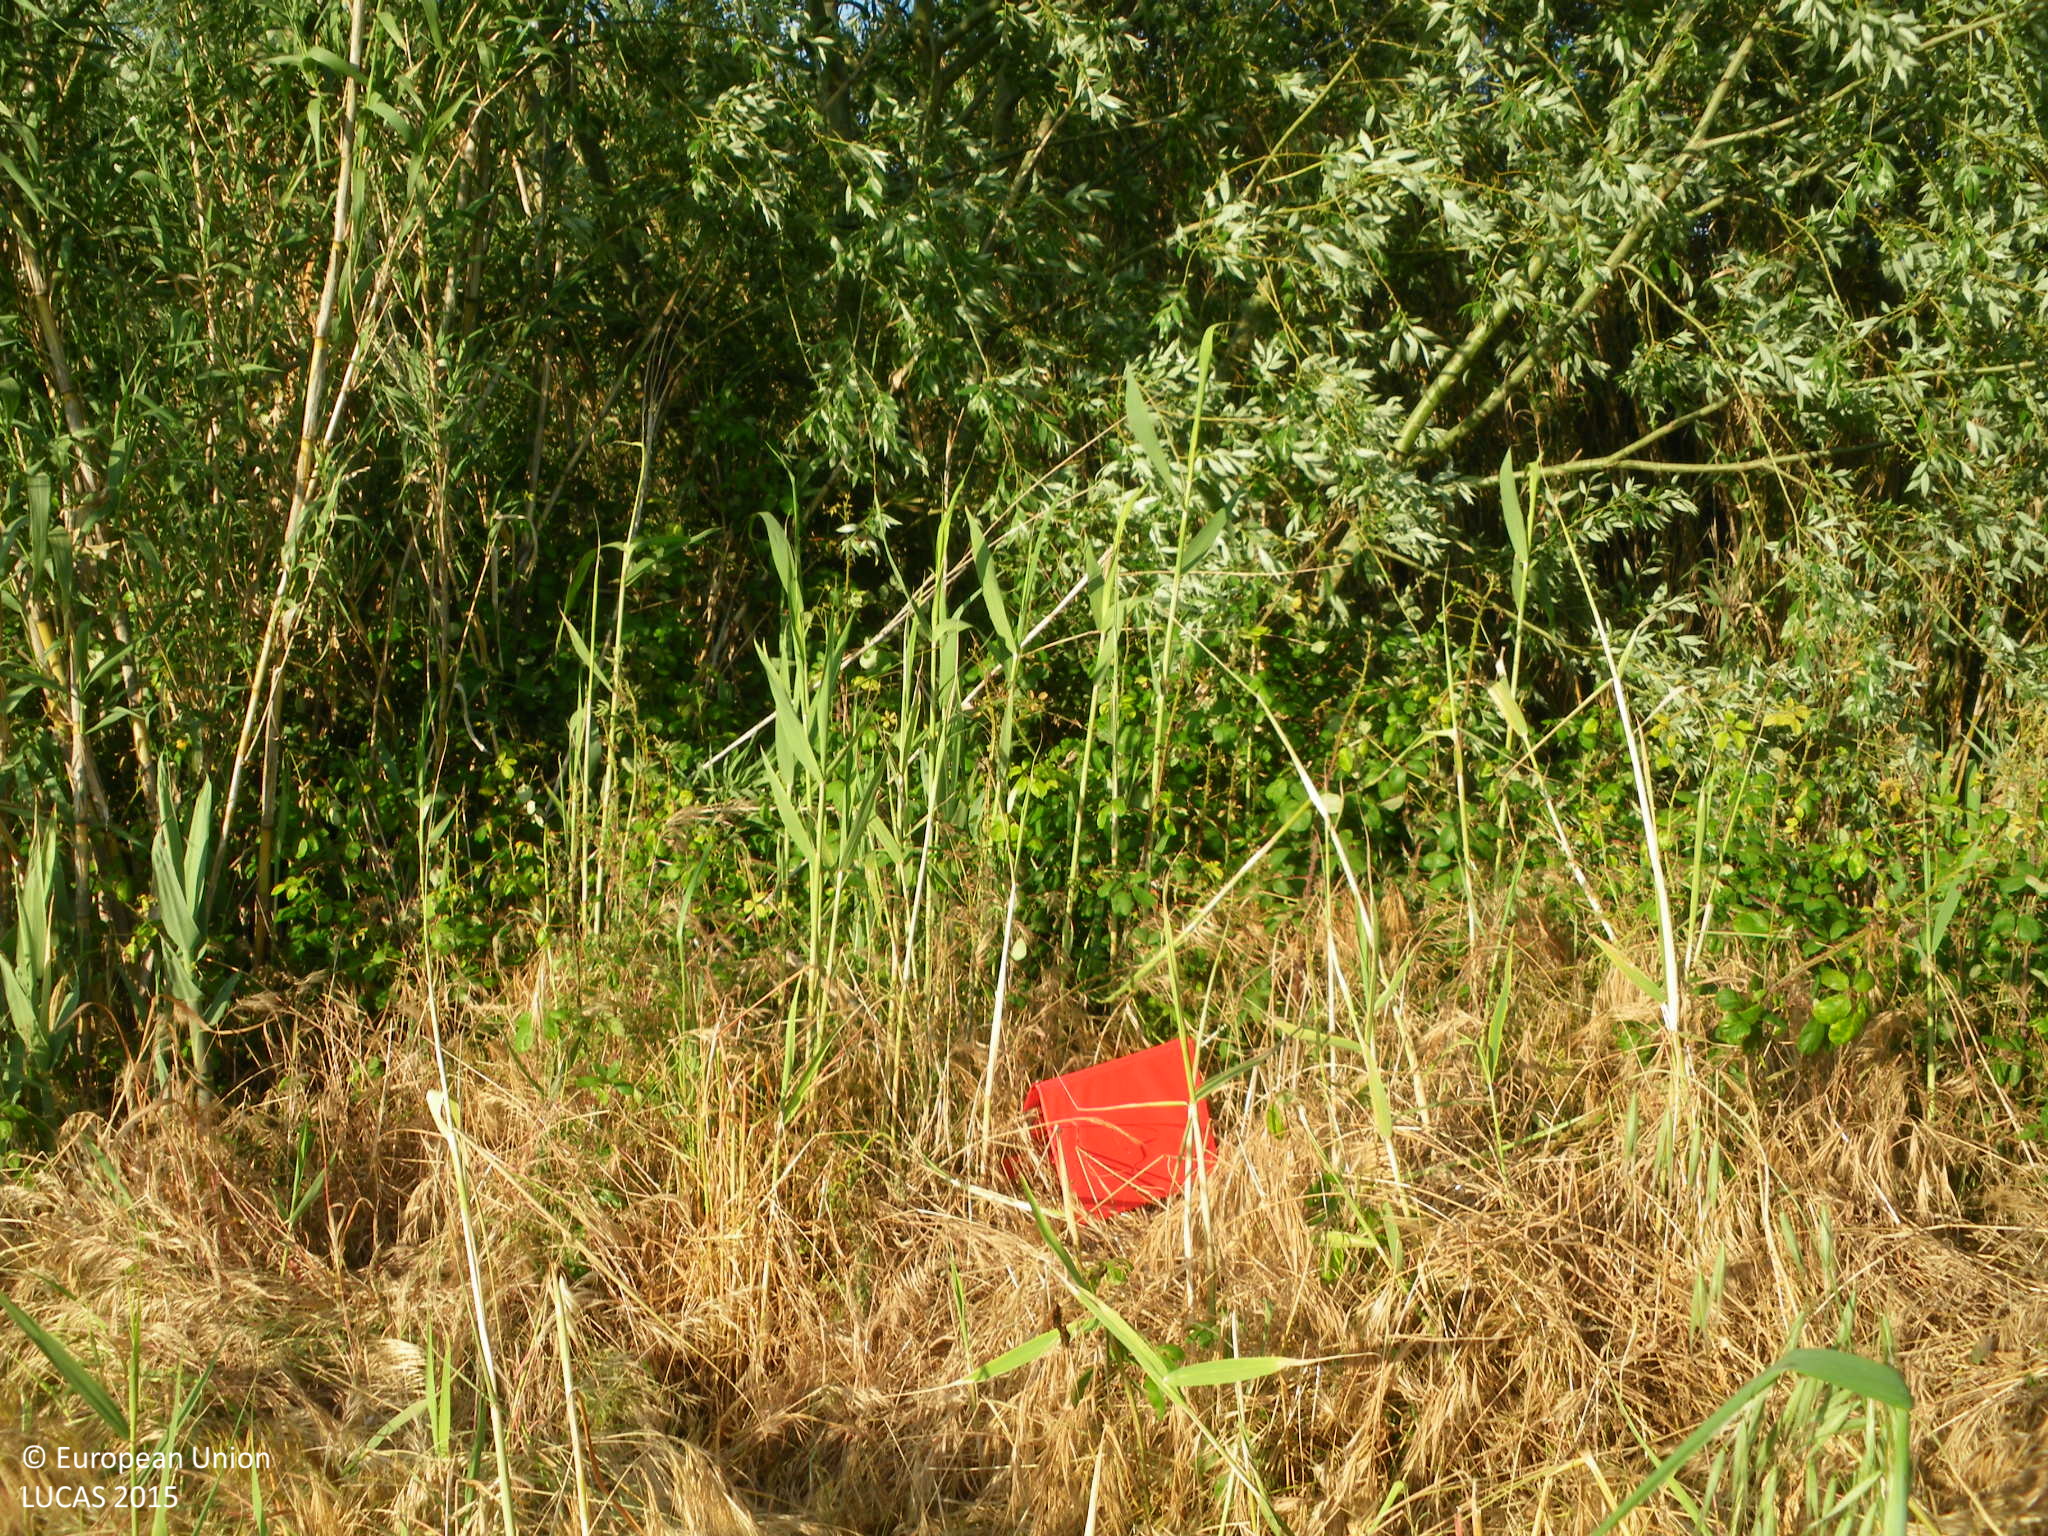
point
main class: Shrubland
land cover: Shrubland with sparse tree cover
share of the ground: > 75 %
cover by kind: shrubs 75 %, herbaceous plants 20 %, broadleaved forest trees 5 %
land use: Semi-natural and natural areas not in use
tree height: > 5 m
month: April
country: ES
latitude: 36.6363
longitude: -5.9227
